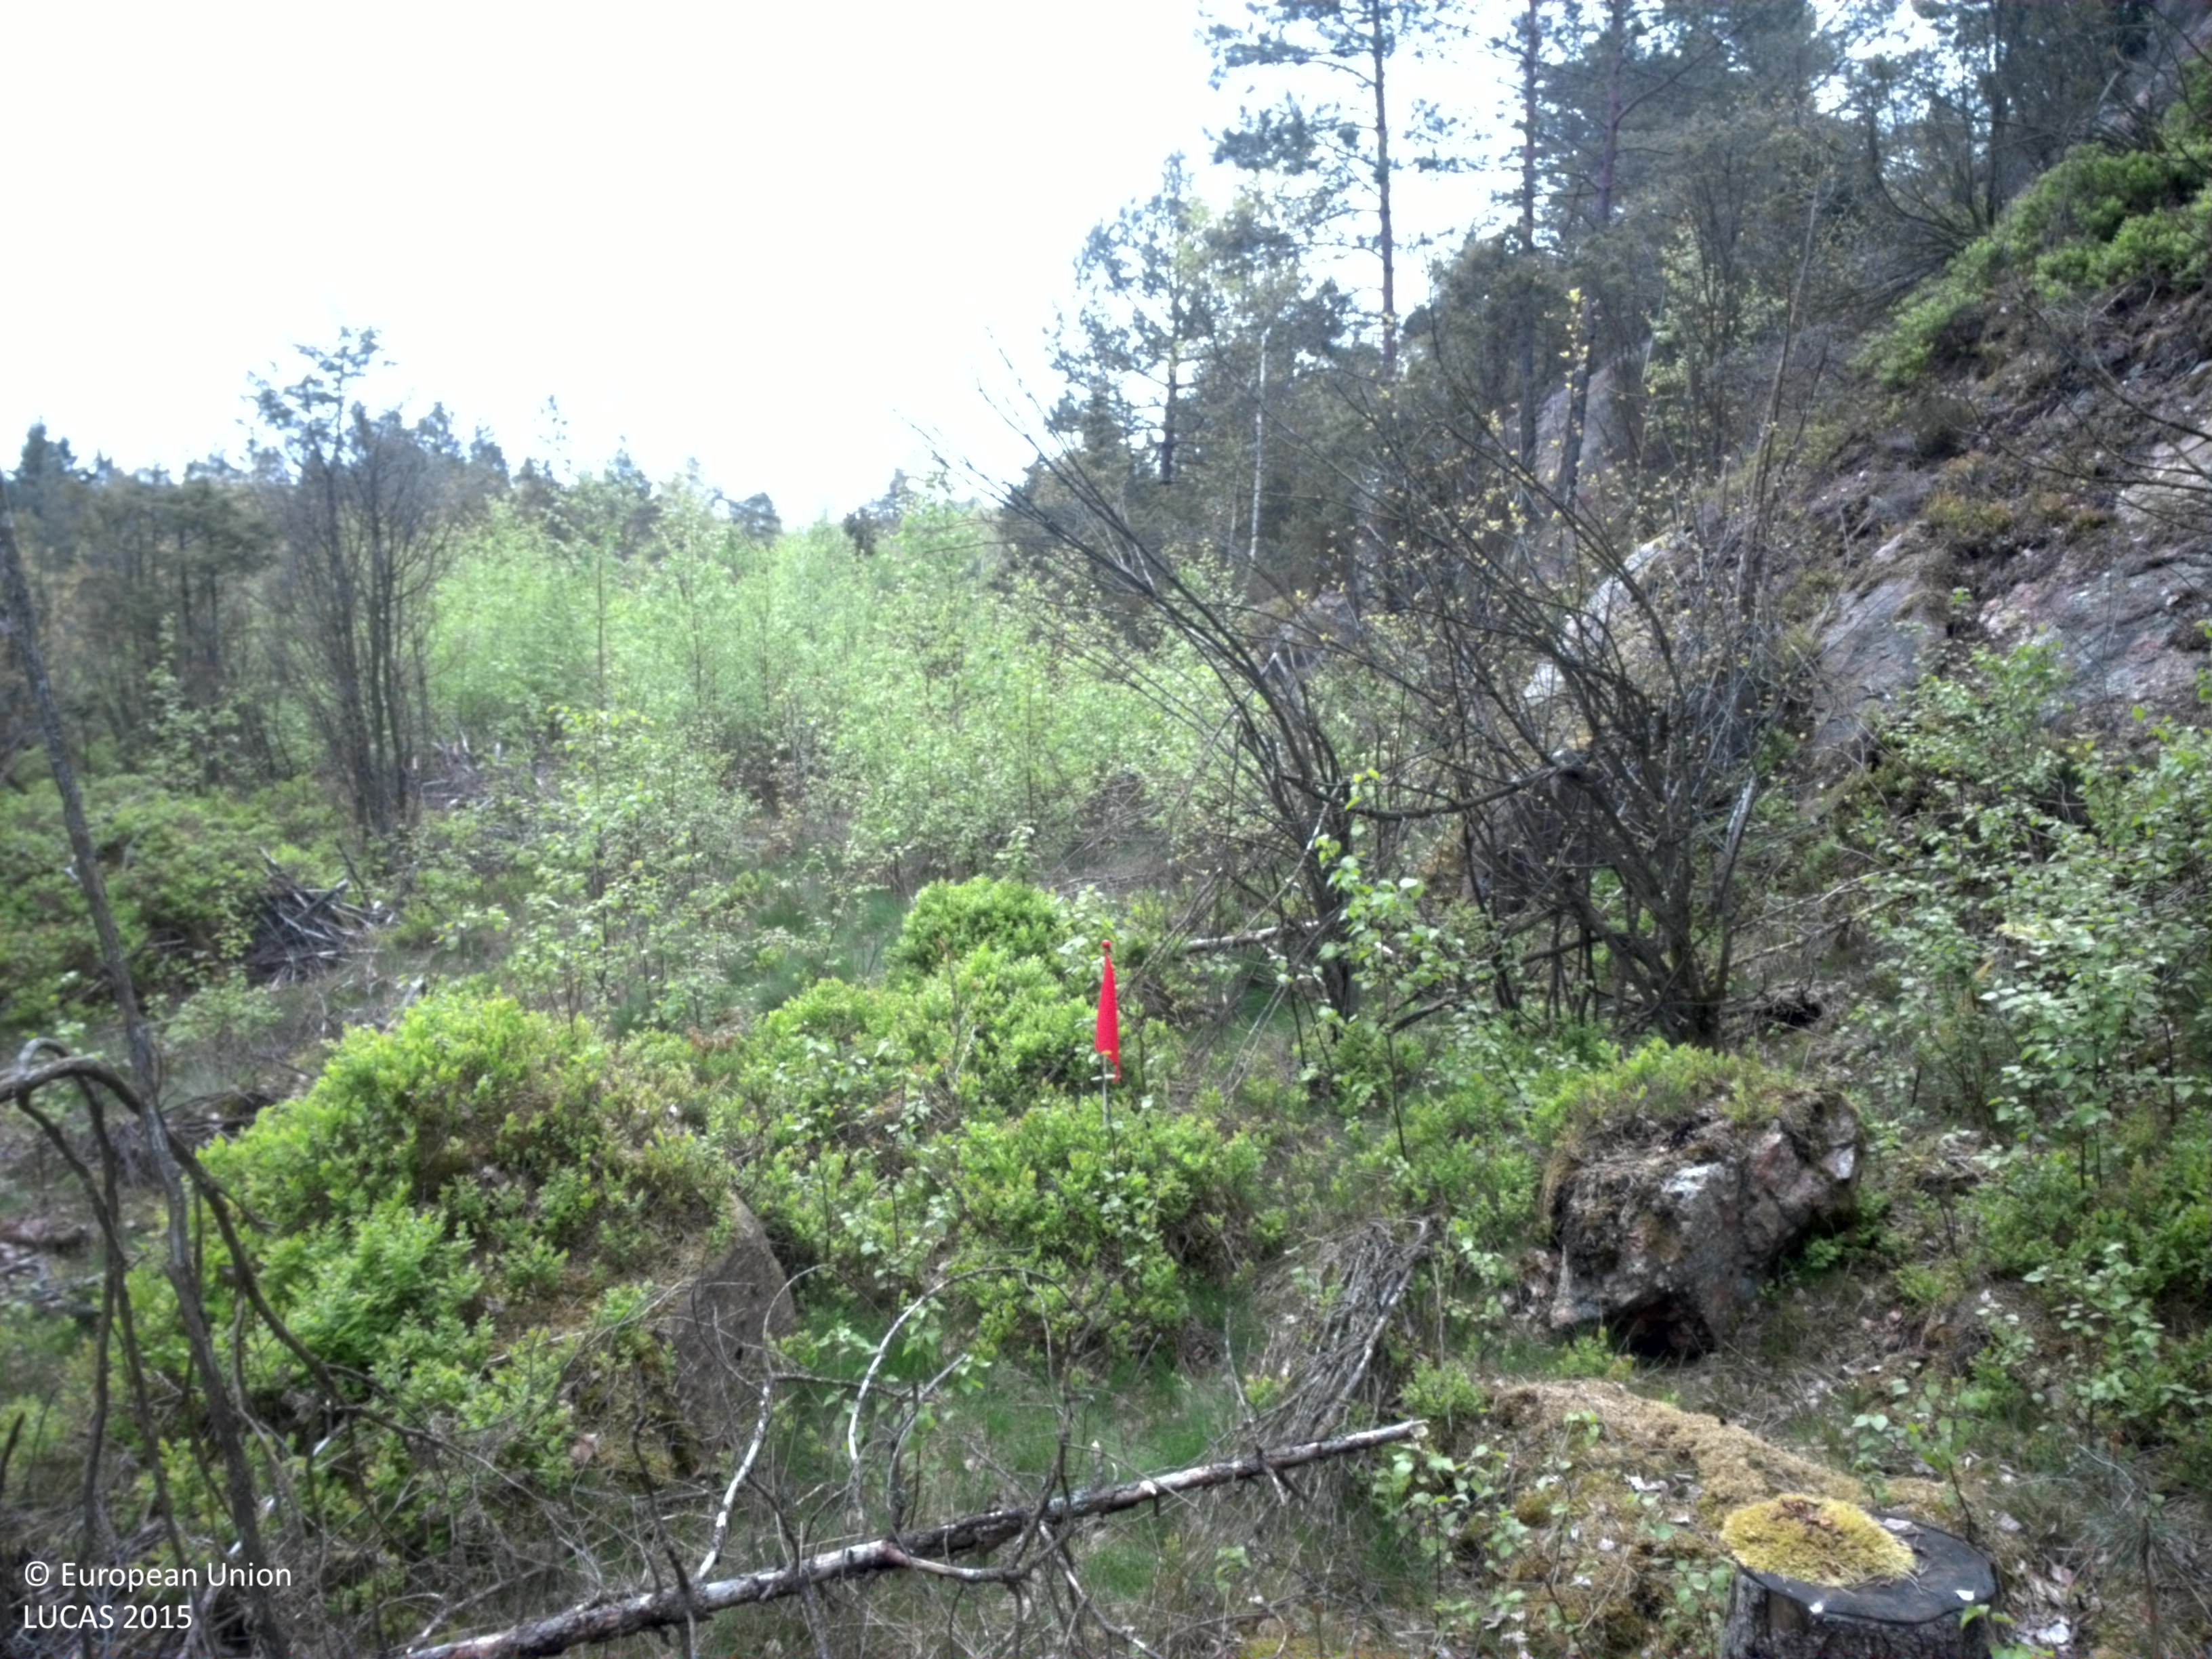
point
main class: Shrubland
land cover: Shrubland with sparse tree cover
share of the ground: > 75 %
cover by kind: herbaceous plants 55 %, shrubs 40 %, coniferous forest trees 5 %
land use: Forestry
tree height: < 5 m
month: May
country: SE
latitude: 57.7734
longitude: 11.9638
